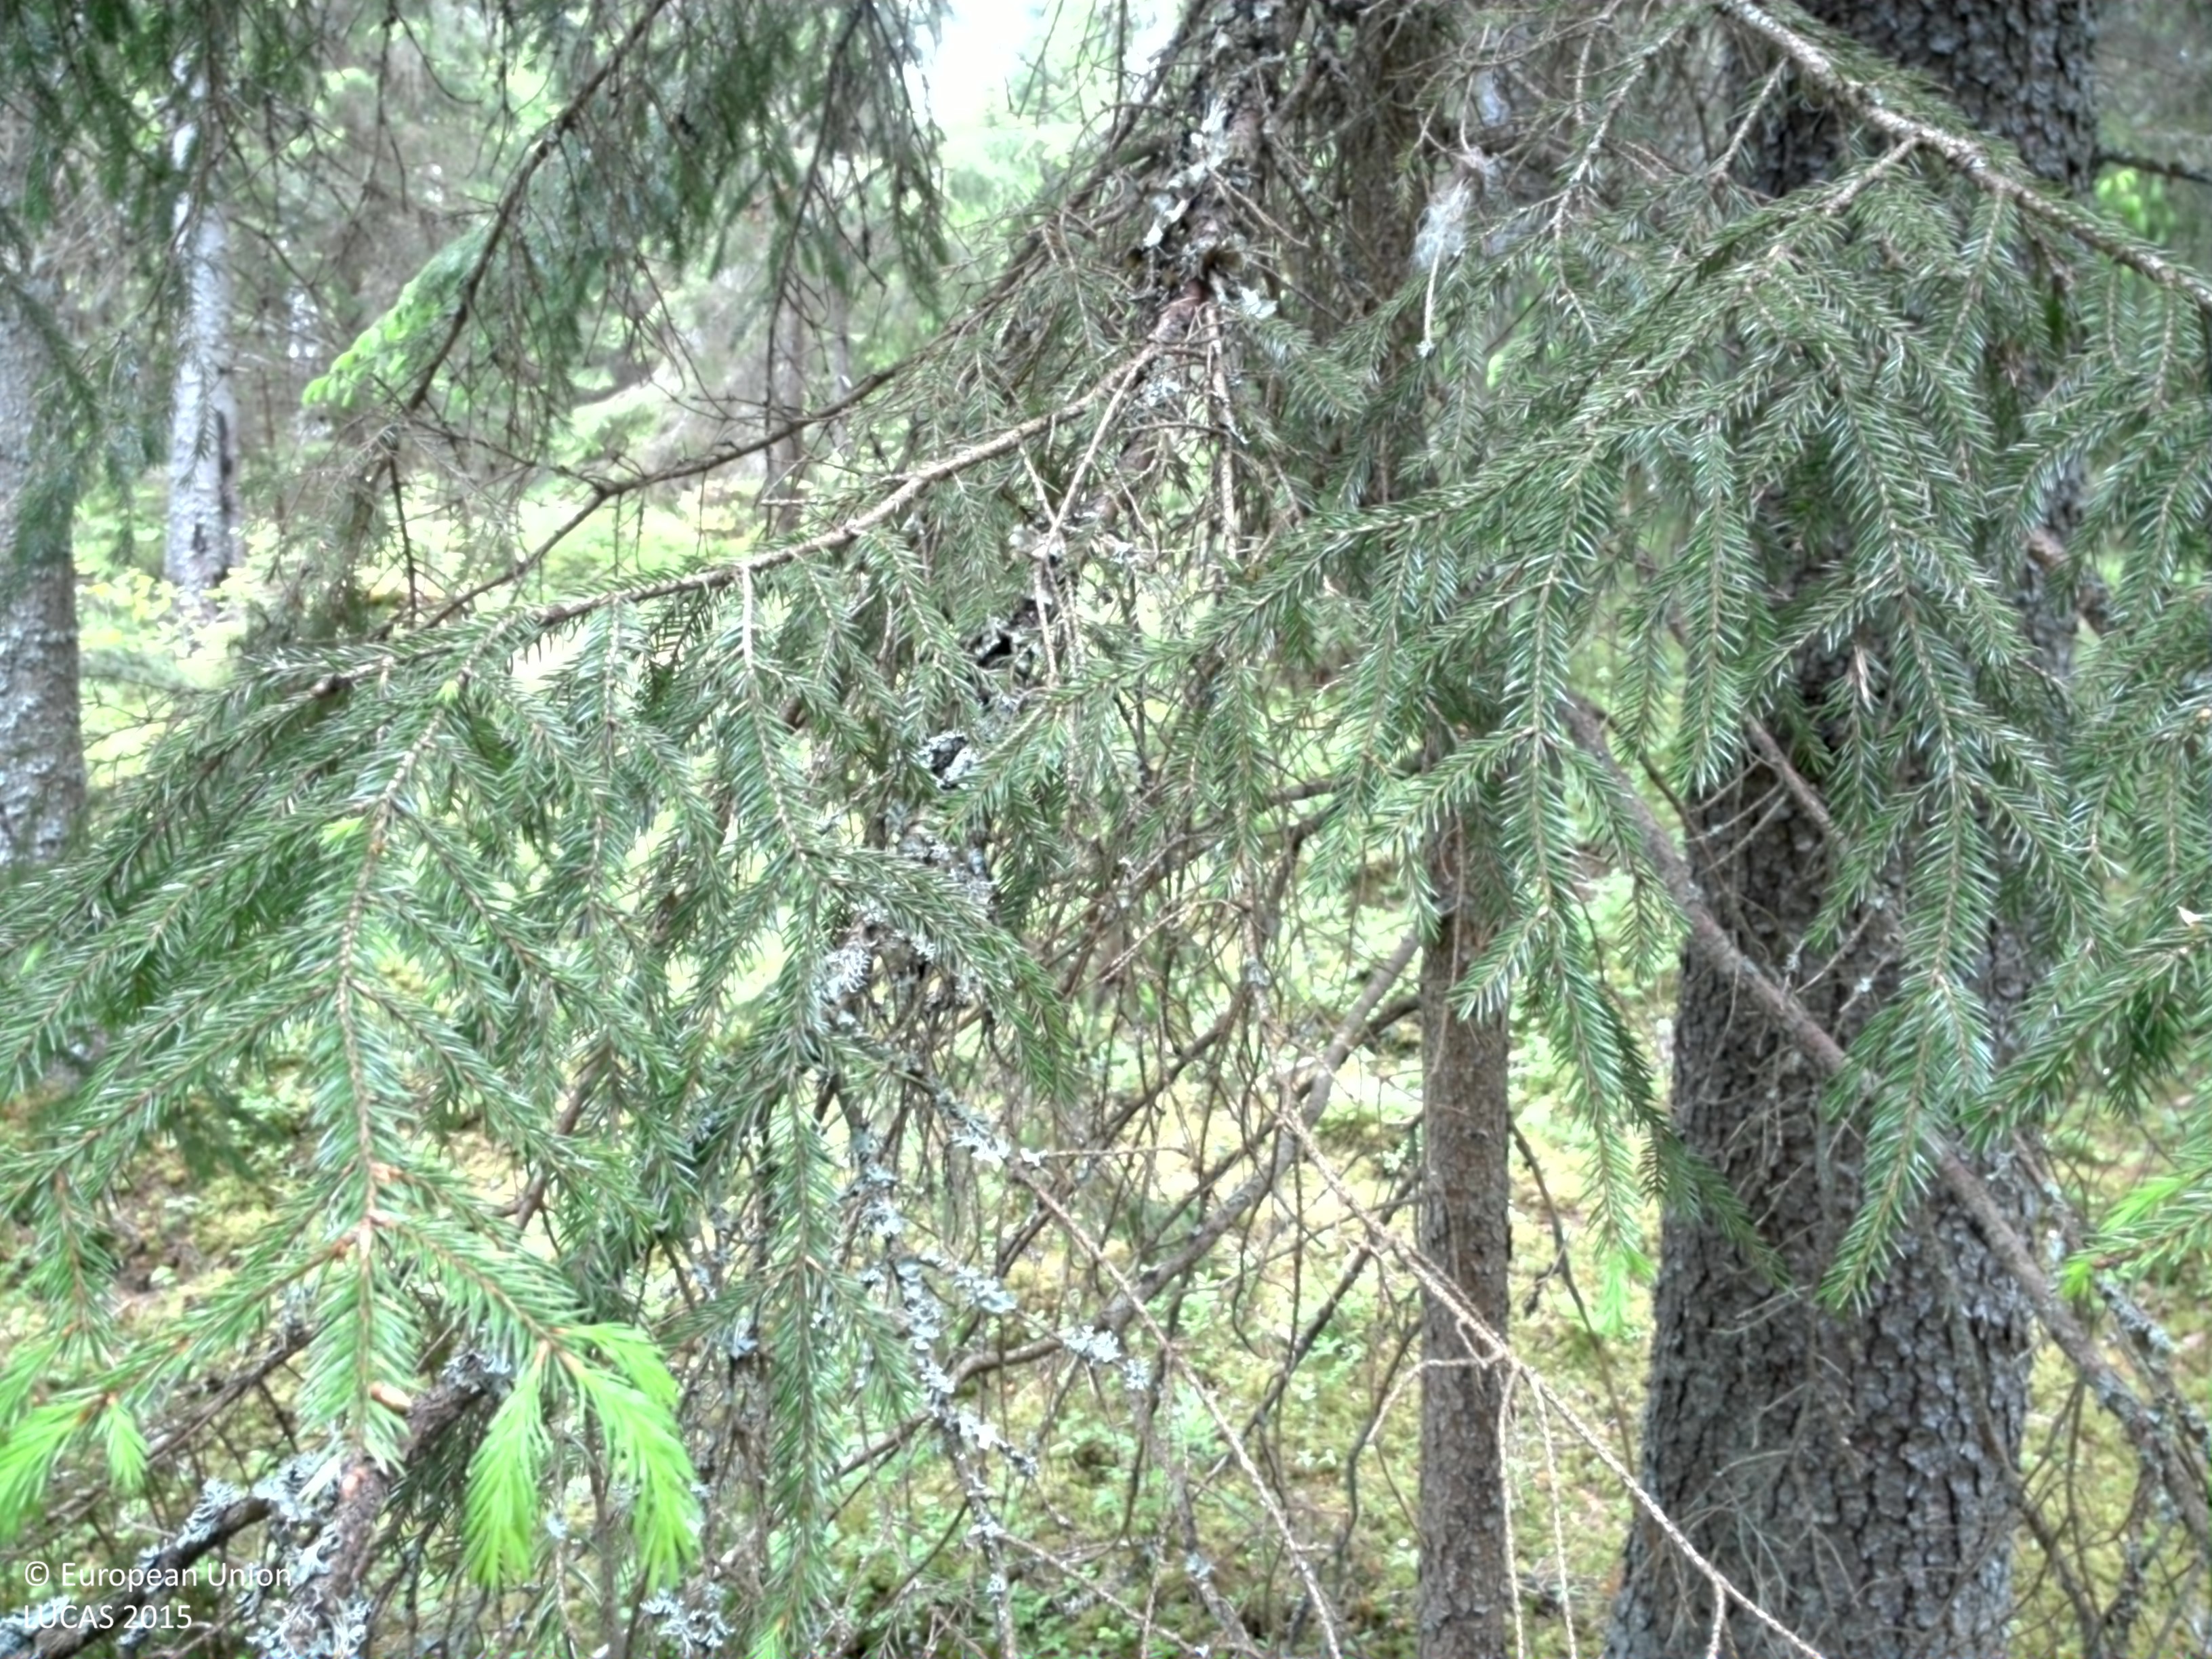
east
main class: Woodland
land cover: Spruce dominated mixed woodland
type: boreal forest
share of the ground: > 75 %
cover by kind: coniferous forest trees 55 %, broadleaved forest trees 25 %, shrubs 10 %, lichens and mosses 10 %
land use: Forestry
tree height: > 5 m
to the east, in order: Spruce dominated mixed woodland; Spruce dominated coniferous woodland; Spruce dominated mixed woodland; Grass margins; Tracks; Grass margins; Ditches and canals; Spruce dominated mixed woodland; Spruce dominated coniferous woodland
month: June
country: SE
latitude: 59.6137
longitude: 14.1914
